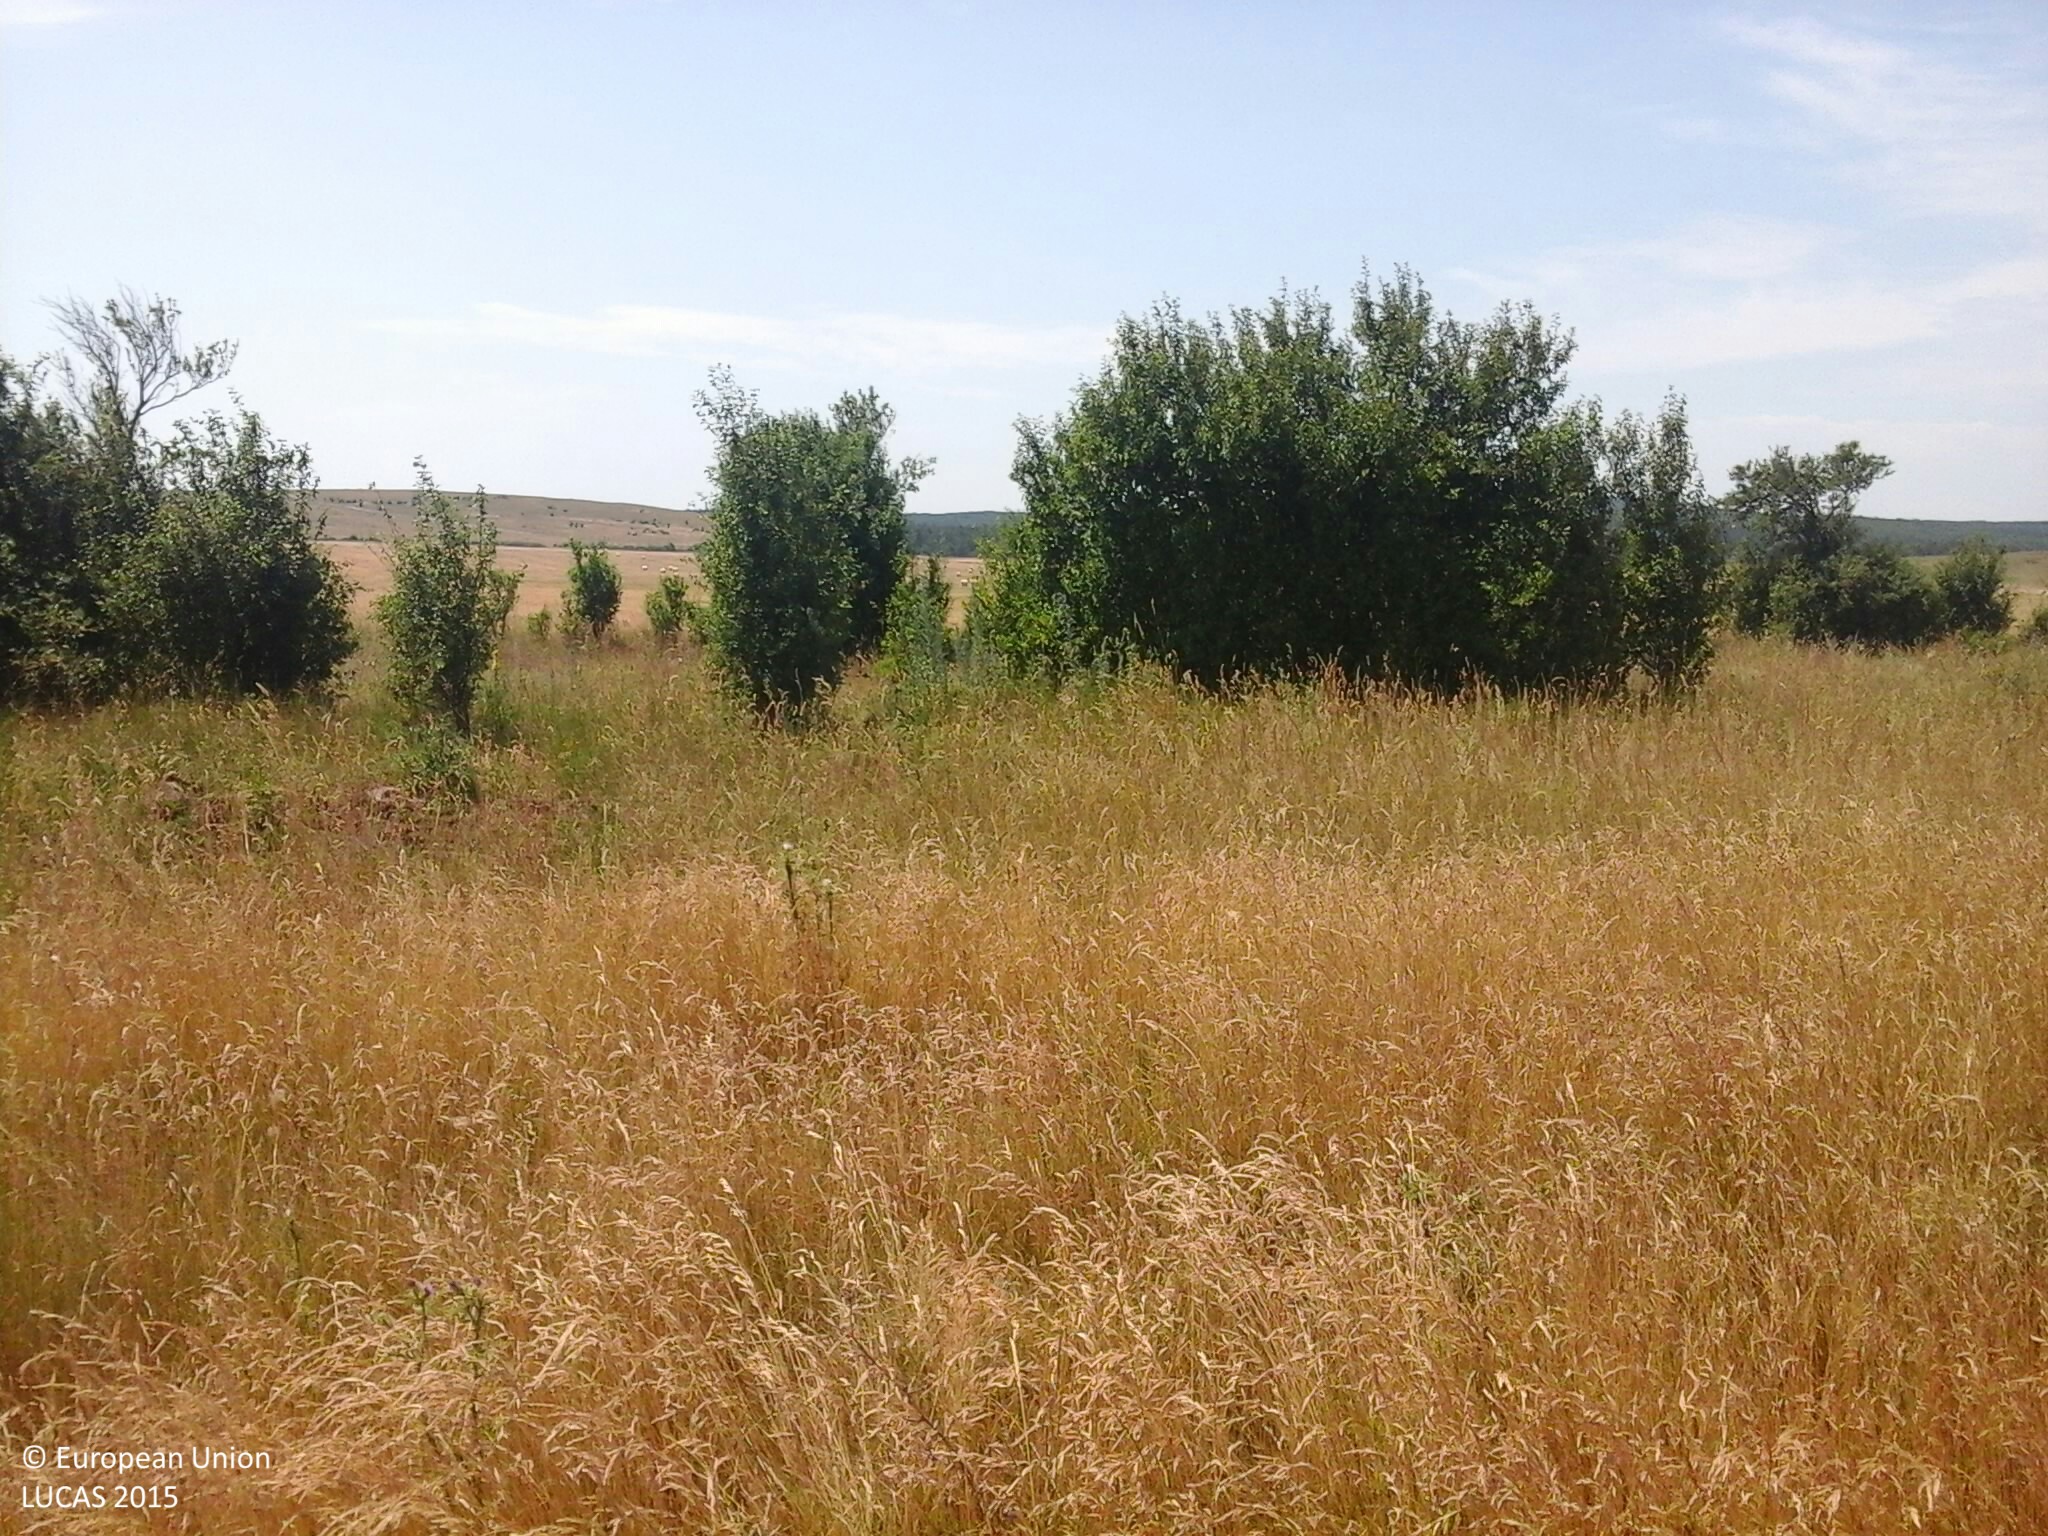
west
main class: Cropland
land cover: Common wheat
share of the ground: 50 - 75 %
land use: Agriculture (excluding fallow land and kitchen gardens)
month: July
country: HU
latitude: 47.0438
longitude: 17.7868
